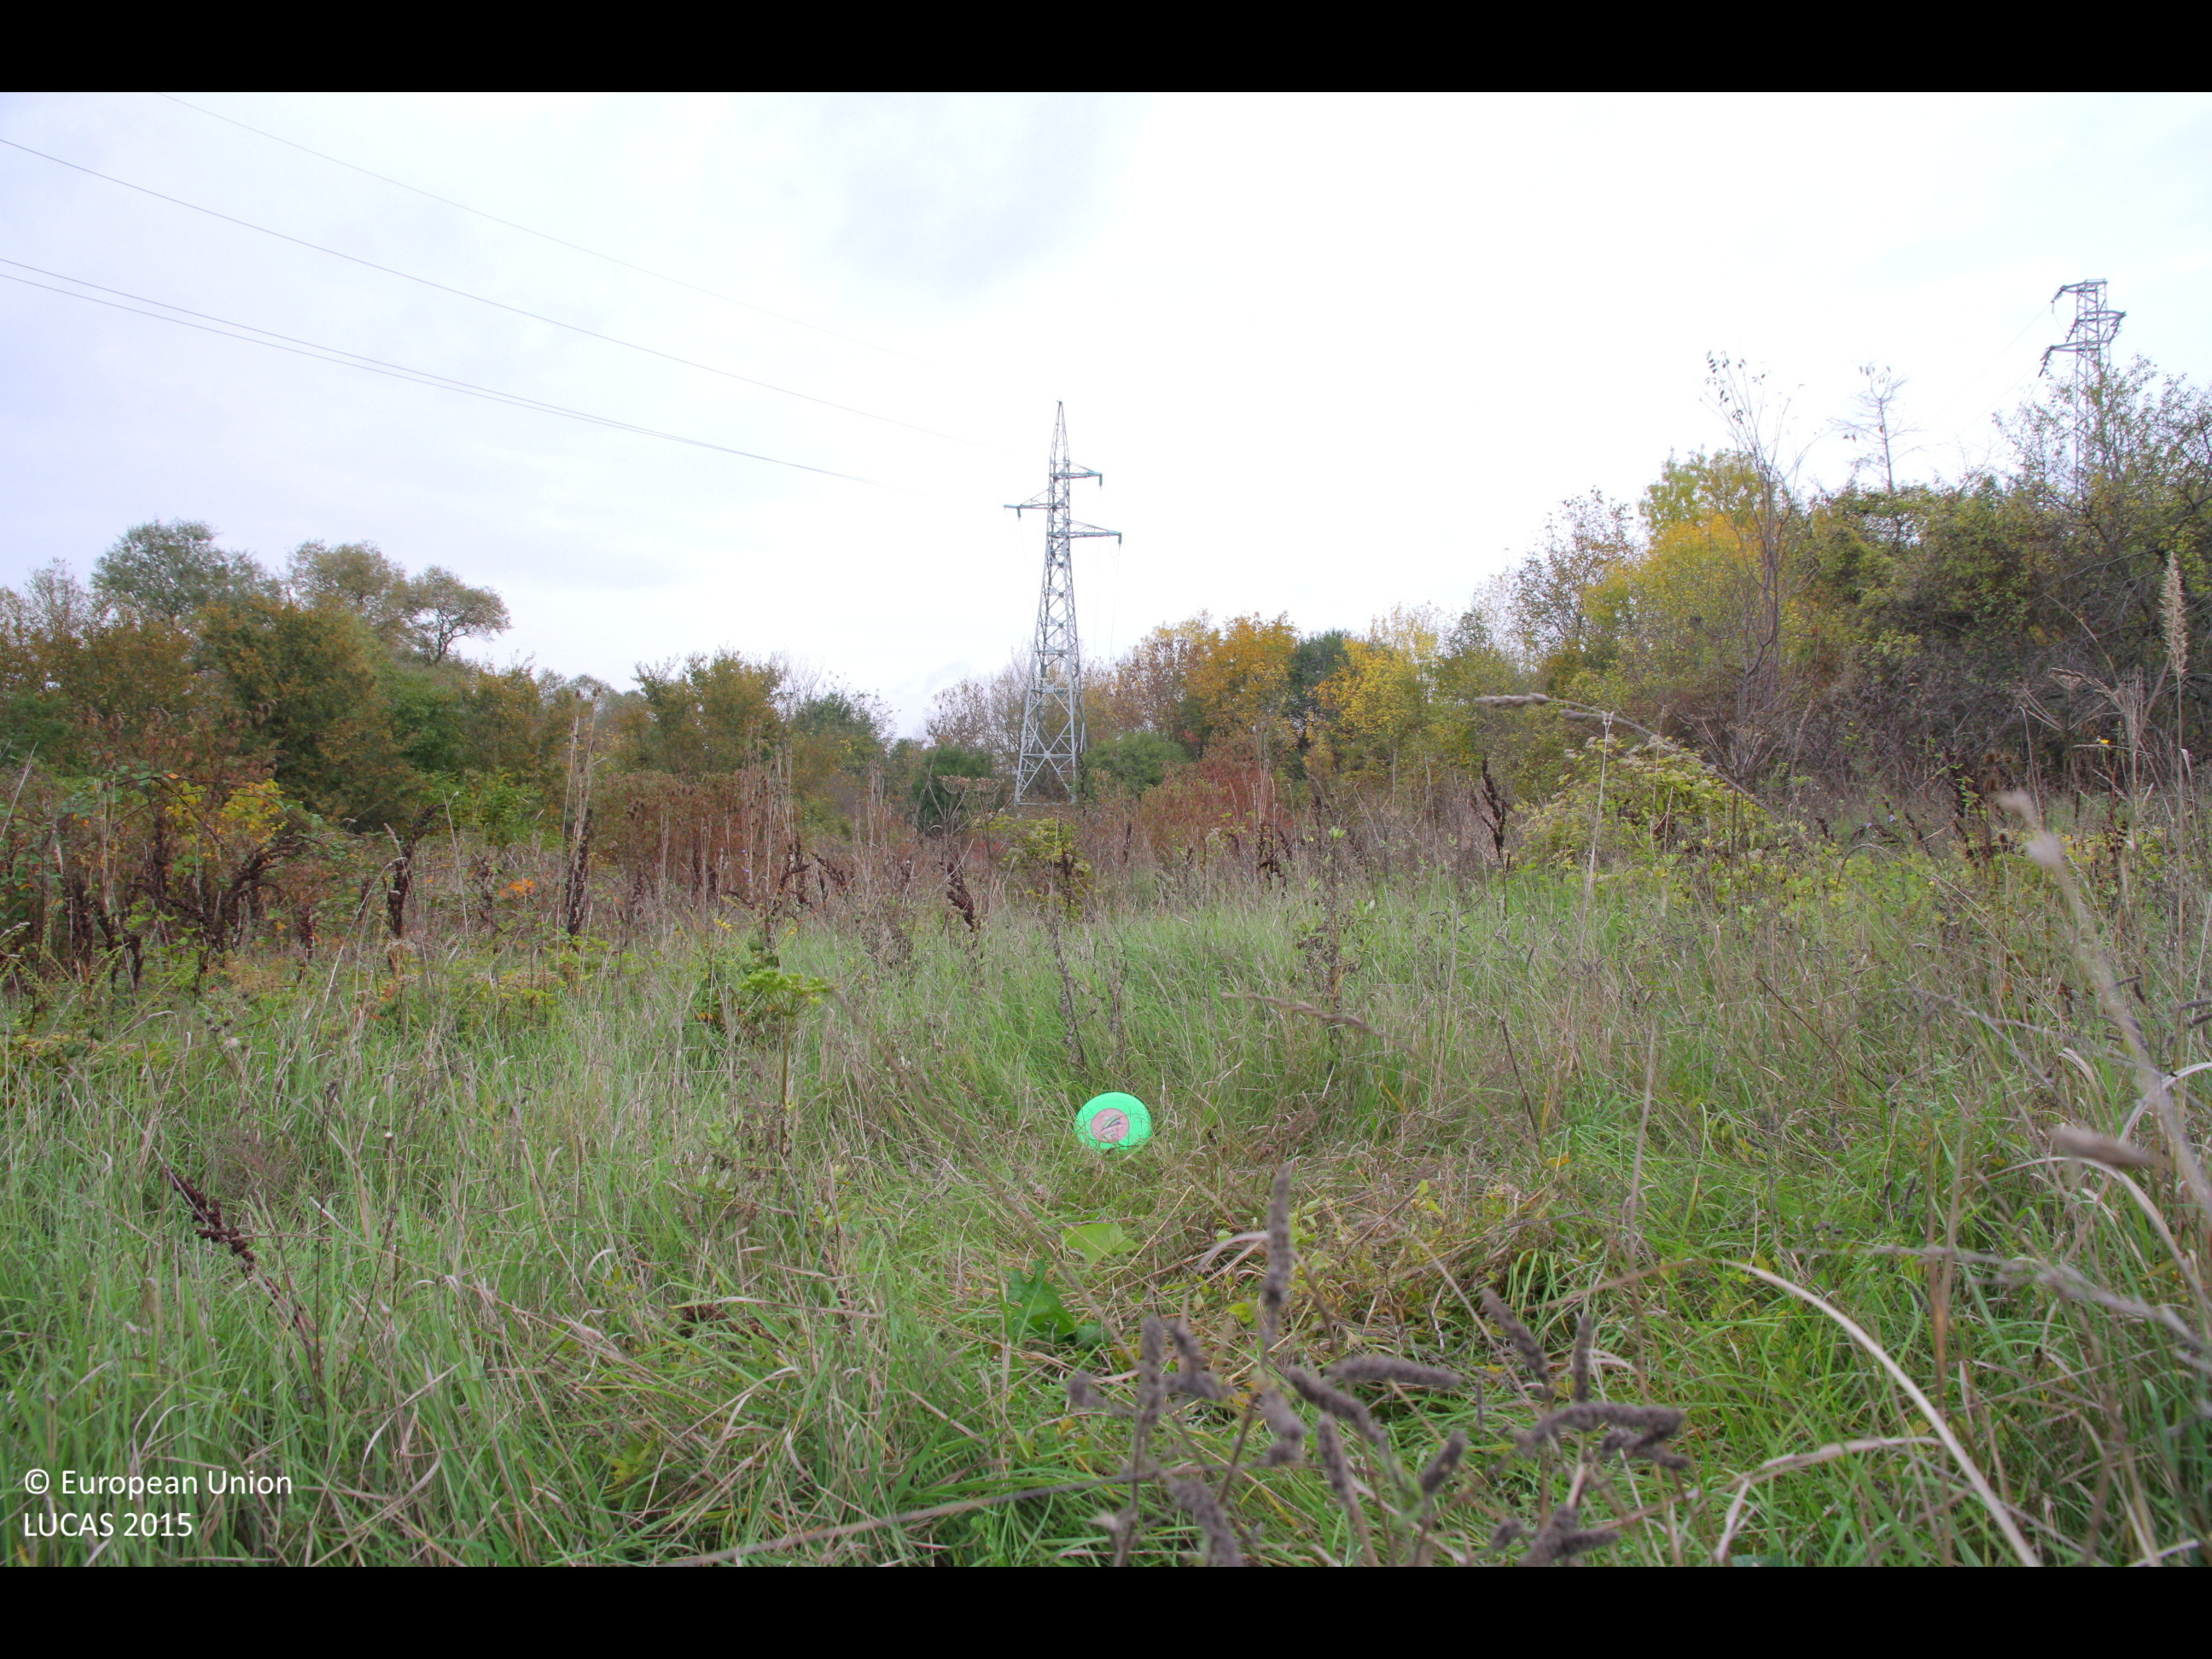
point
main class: Grassland
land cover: Grassland without tree/shrub cover
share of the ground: > 75 %
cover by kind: herbaceous plants 95 %, shrubs 5 %
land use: Semi-natural and natural areas not in use
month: October
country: BG
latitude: 43.2912
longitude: 26.9623
